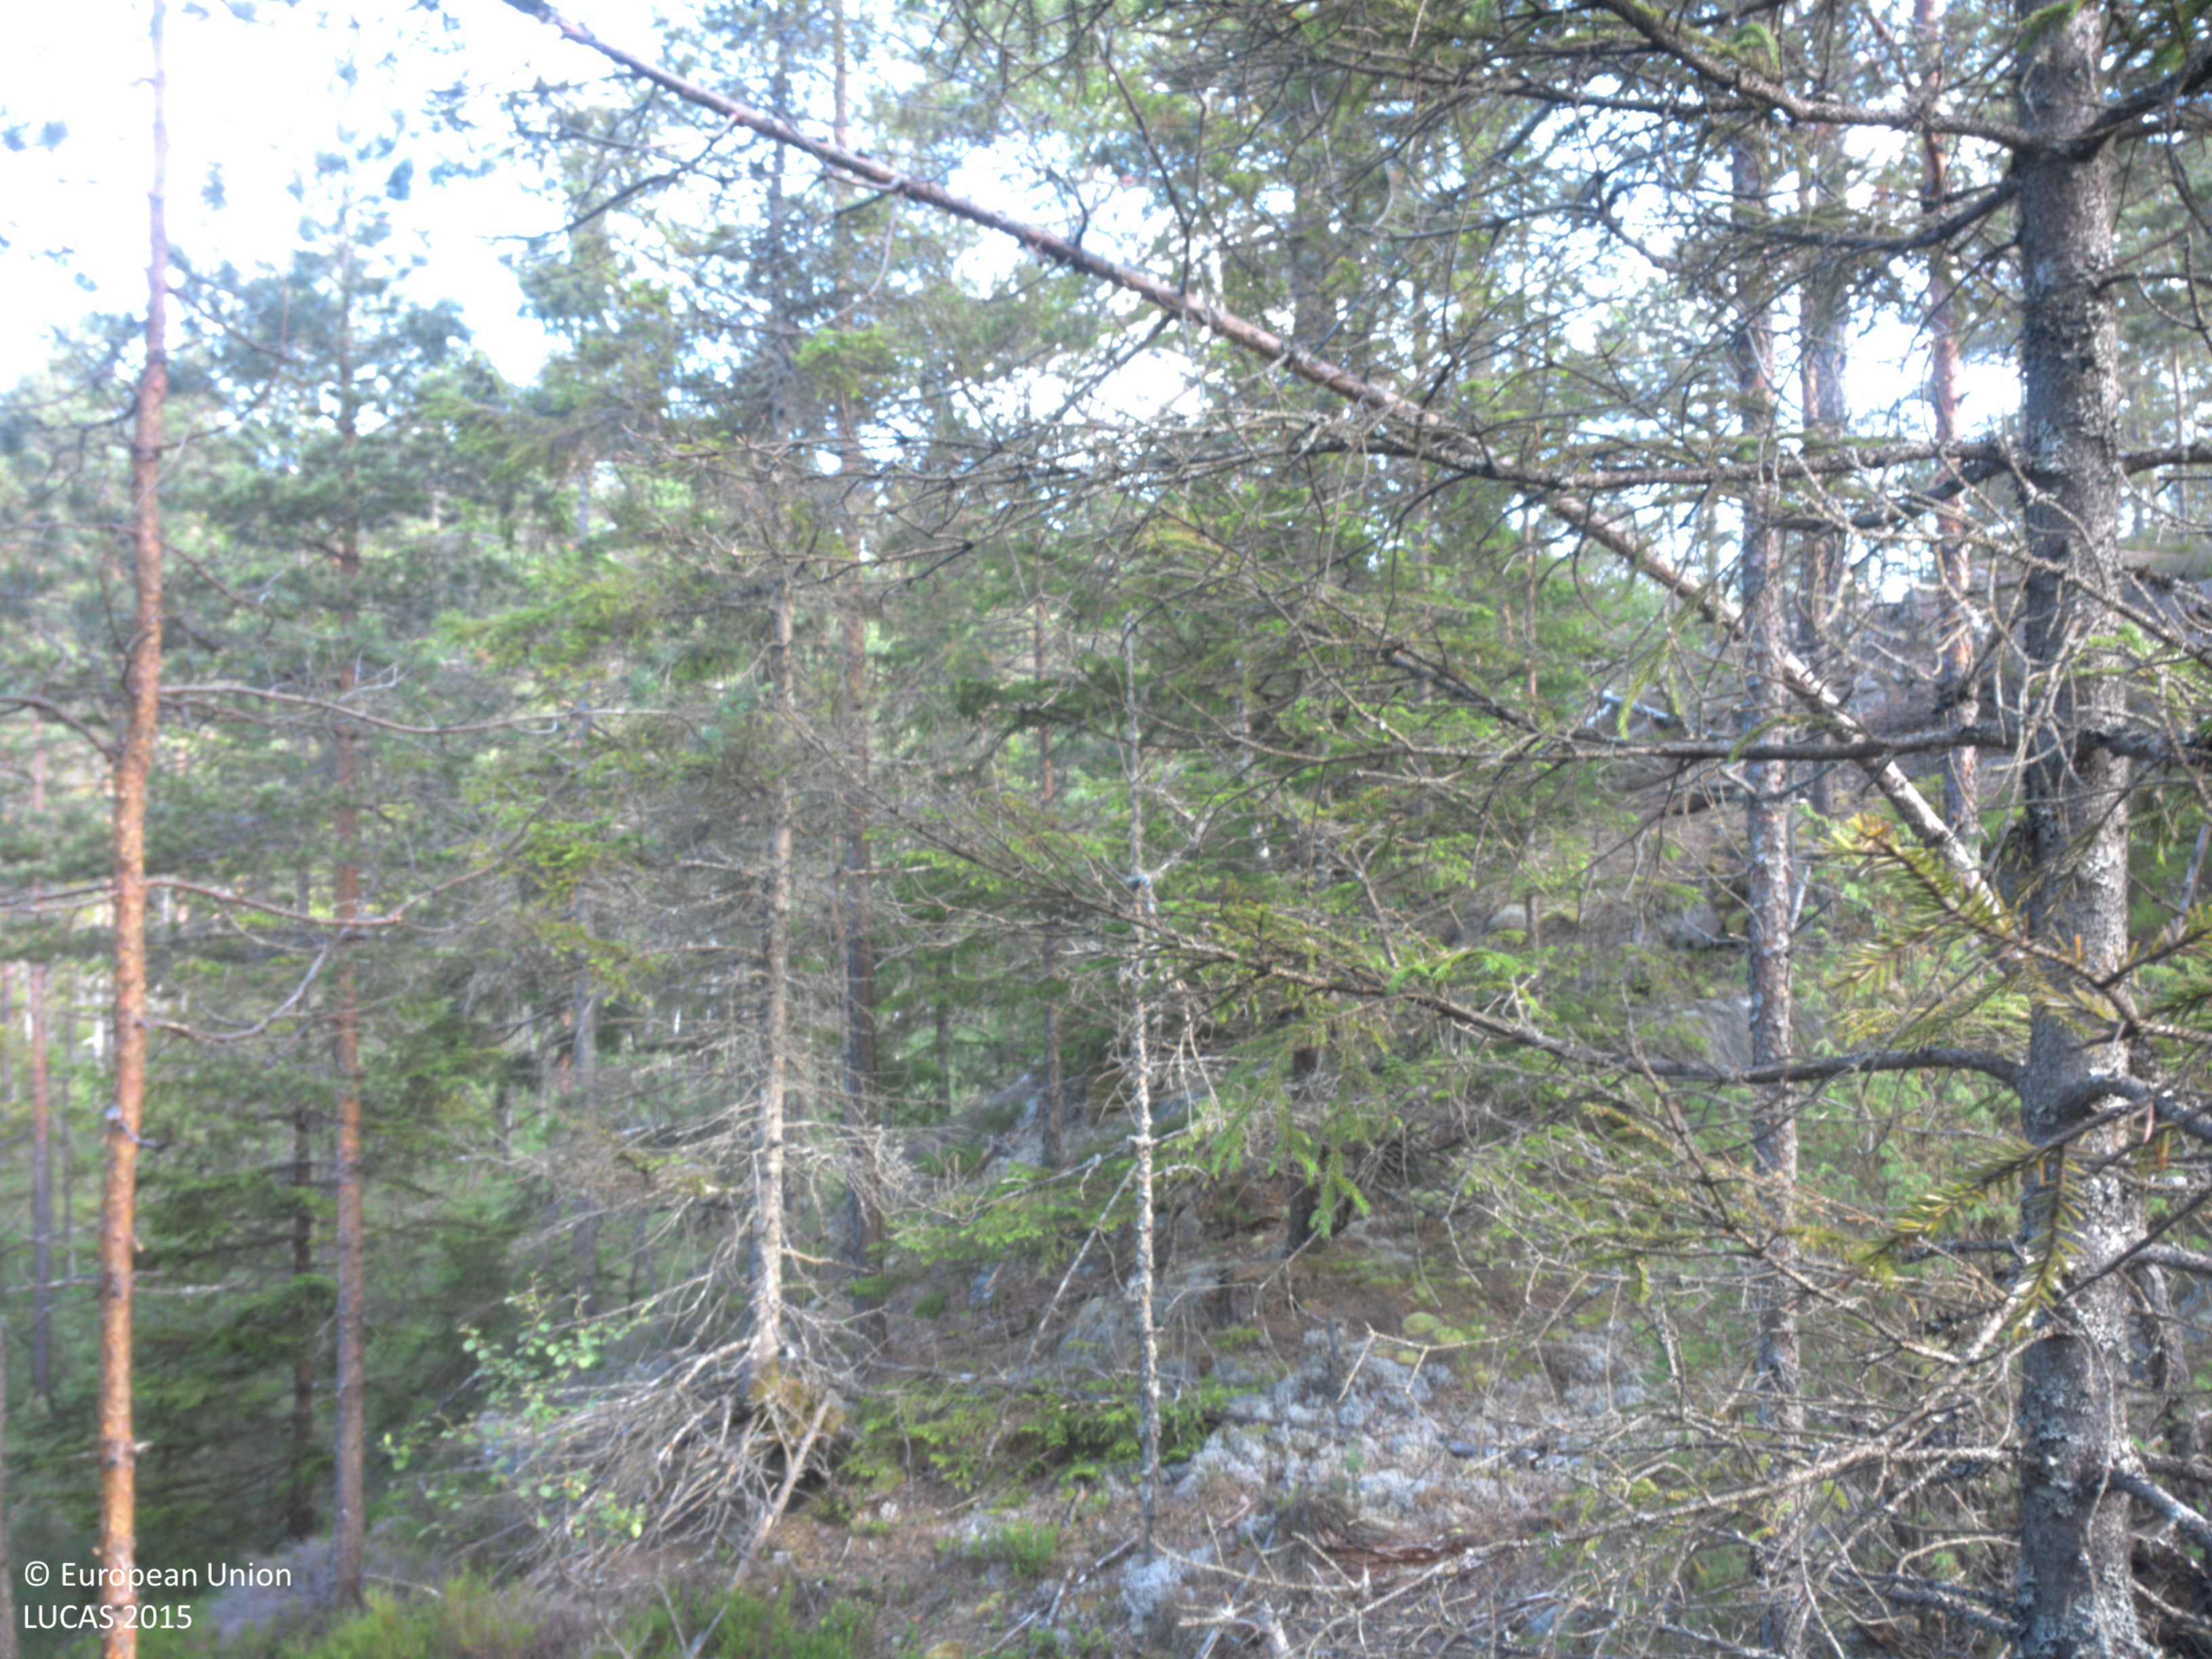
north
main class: Woodland
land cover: Pine dominated coniferous woodland
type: boreal forest
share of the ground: 25 - 50 %
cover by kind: coniferous forest trees 40 %, shrubs 30 %, lichens and mosses 30 %
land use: Forestry
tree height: > 5 m
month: July
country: SE
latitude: 58.8370
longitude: 11.8150
